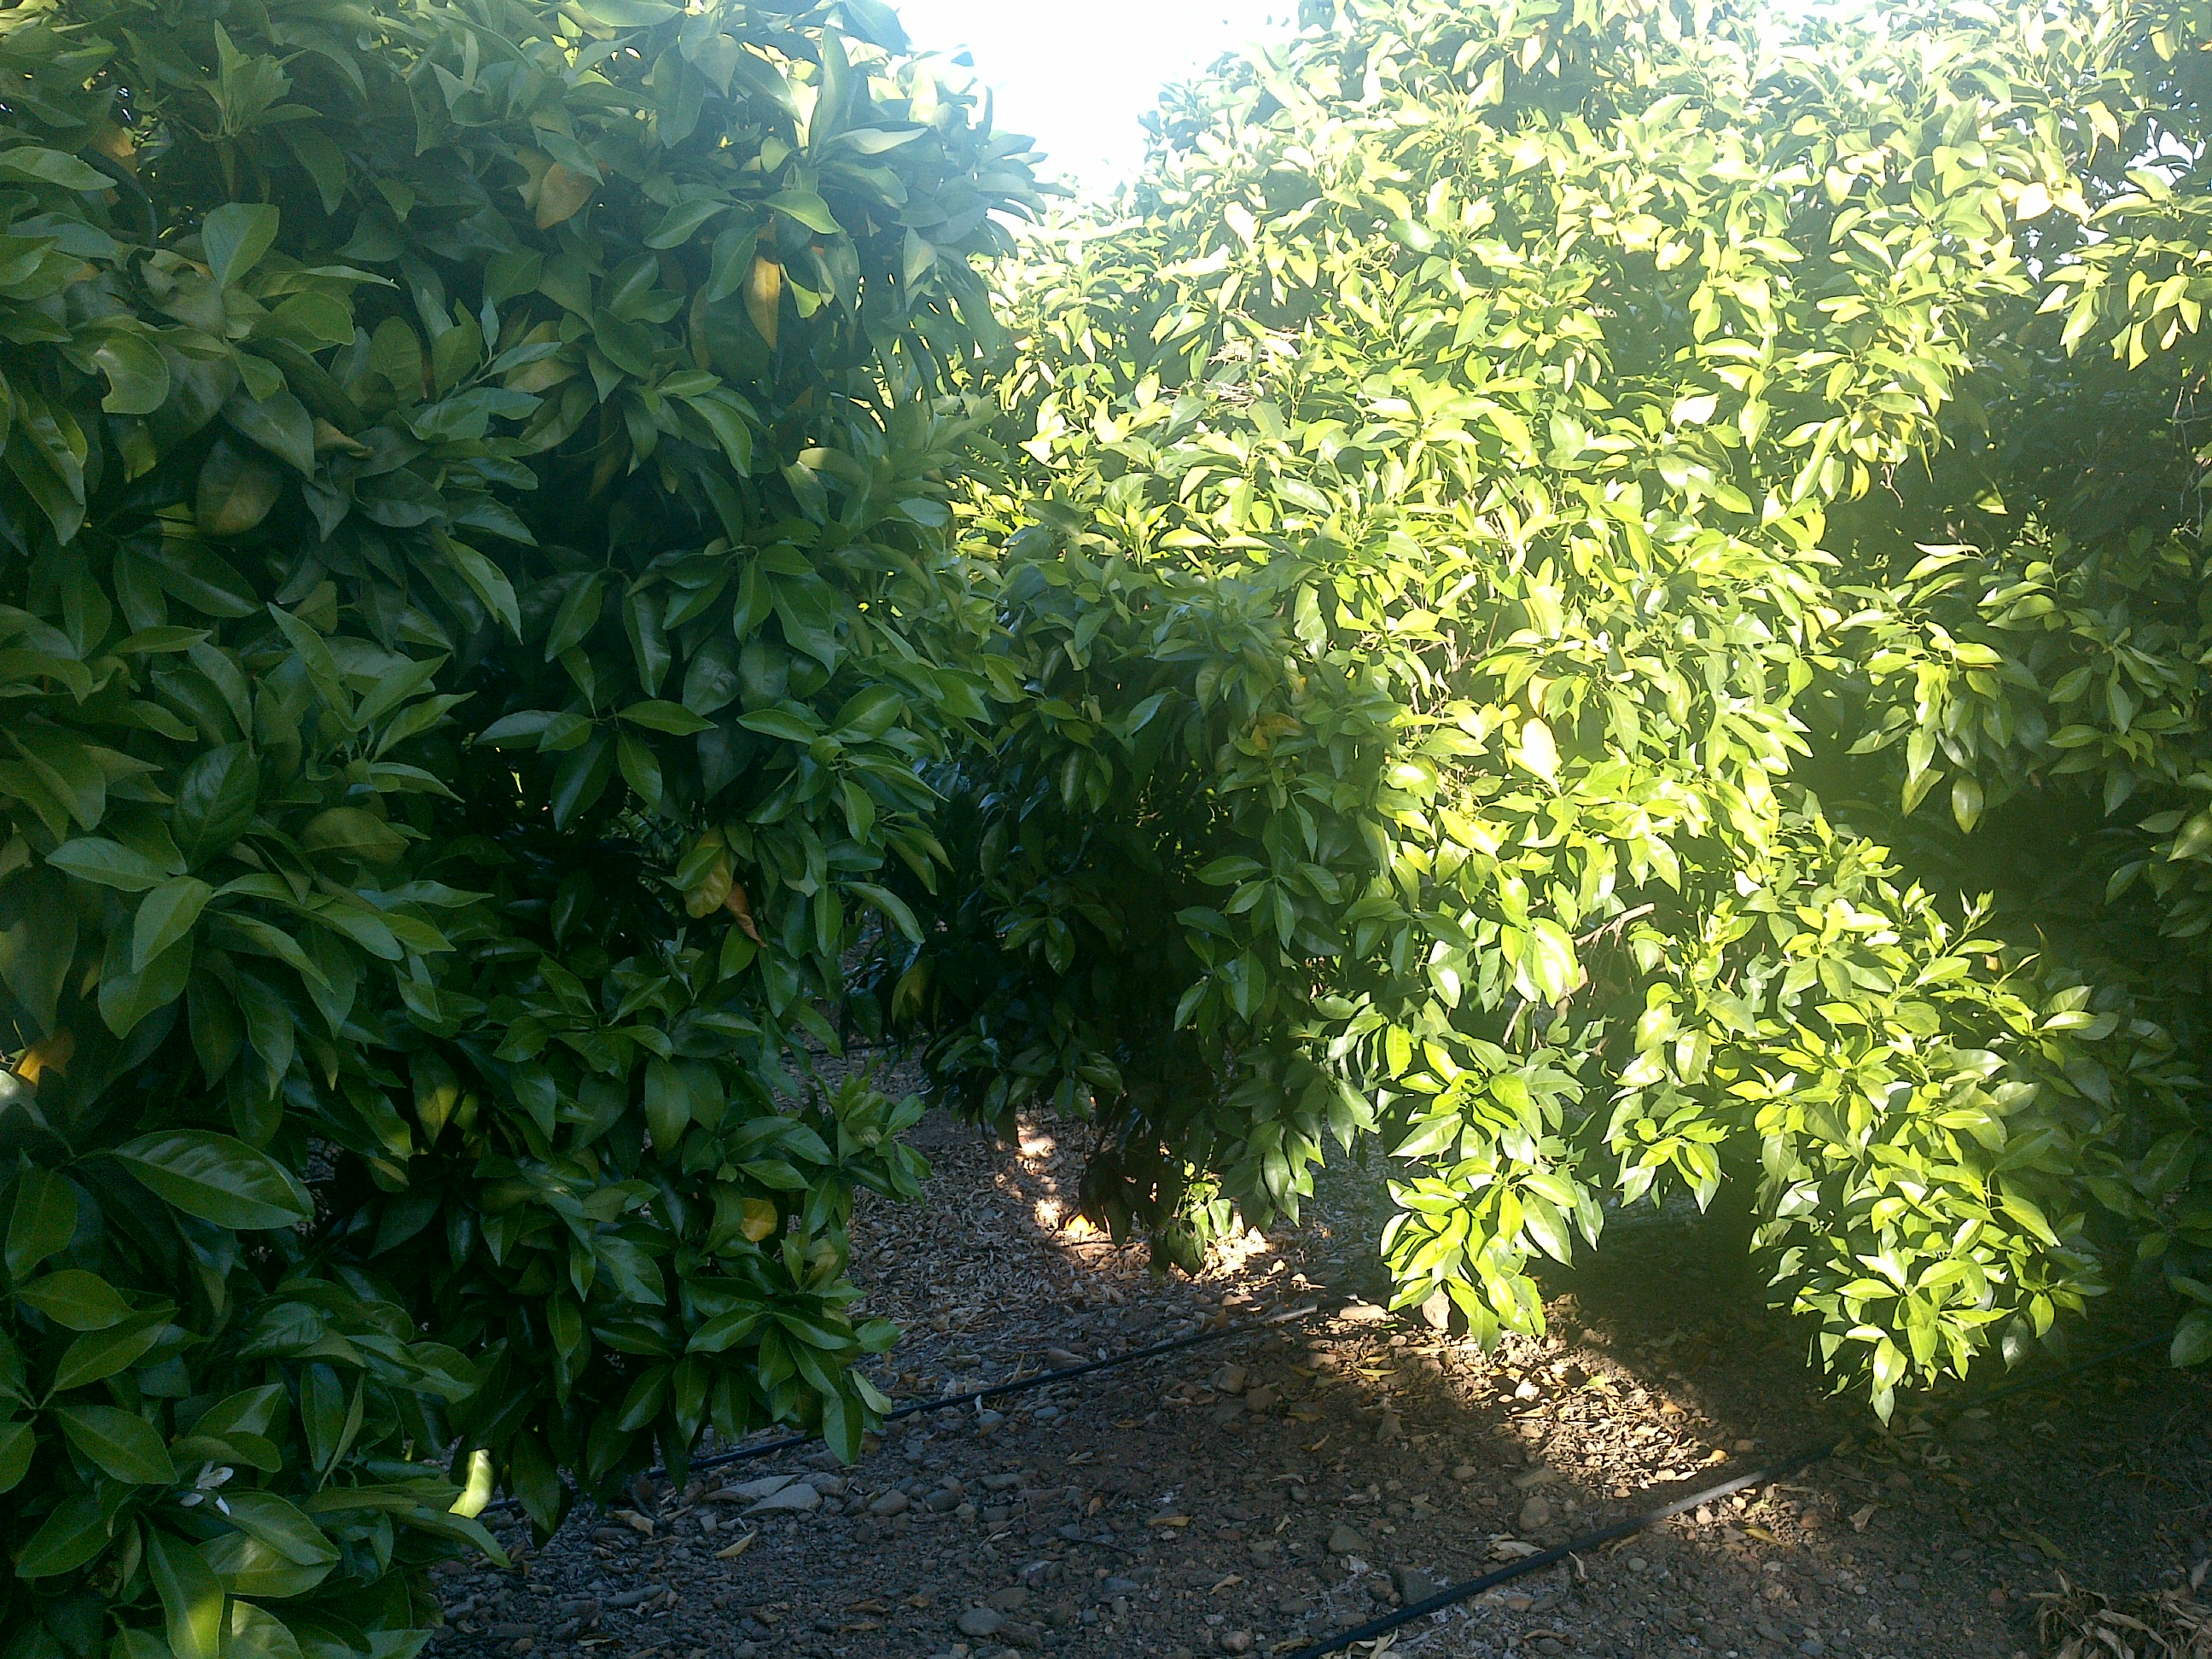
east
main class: Cropland
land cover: Oranges
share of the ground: > 75 %
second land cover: Other bare soil
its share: > 75 %
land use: Agriculture (excluding fallow land and kitchen gardens)
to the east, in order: Oranges; Other bare soil; Grass margins; Ditches and canals; Grass margins; Oranges
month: May
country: ES
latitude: 37.8021
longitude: -5.2270
